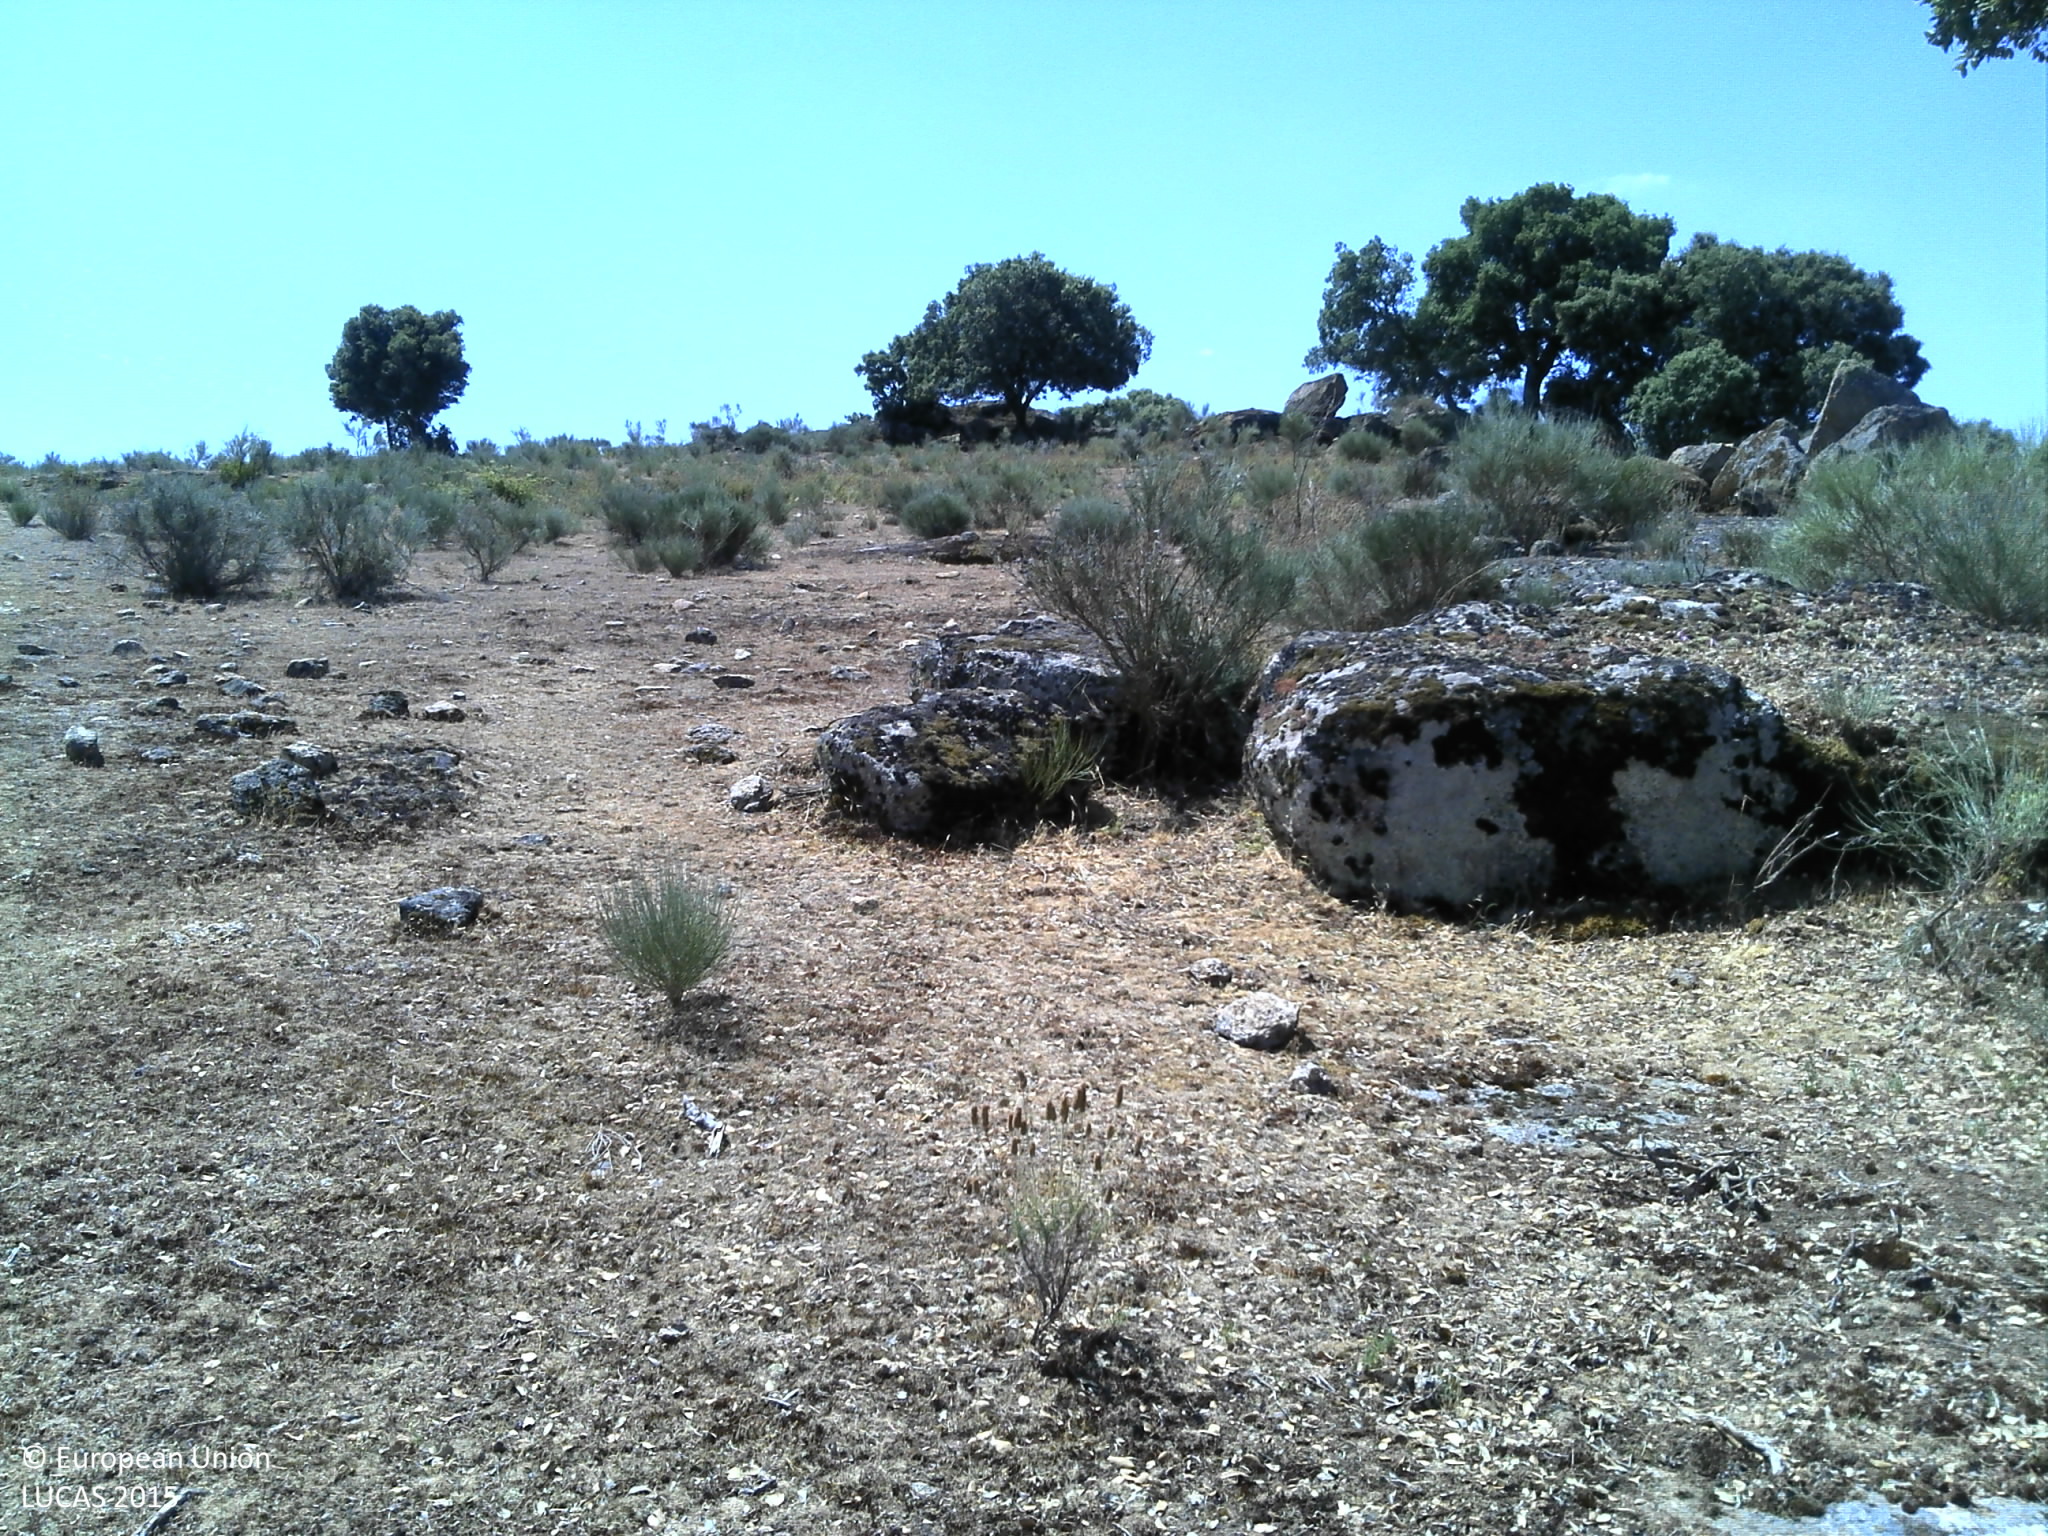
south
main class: Grassland
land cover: Grassland with sparse tree/shrub cover
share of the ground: 25 - 50 %
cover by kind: consolidated bare surface 45 %, herbaceous plants 40 %, shrubs 10 %, broadleaved forest trees 5 %
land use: Agriculture (excluding fallow land and kitchen gardens)
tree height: > 5 m
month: June
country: PT
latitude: 40.7692
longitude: -6.9609
